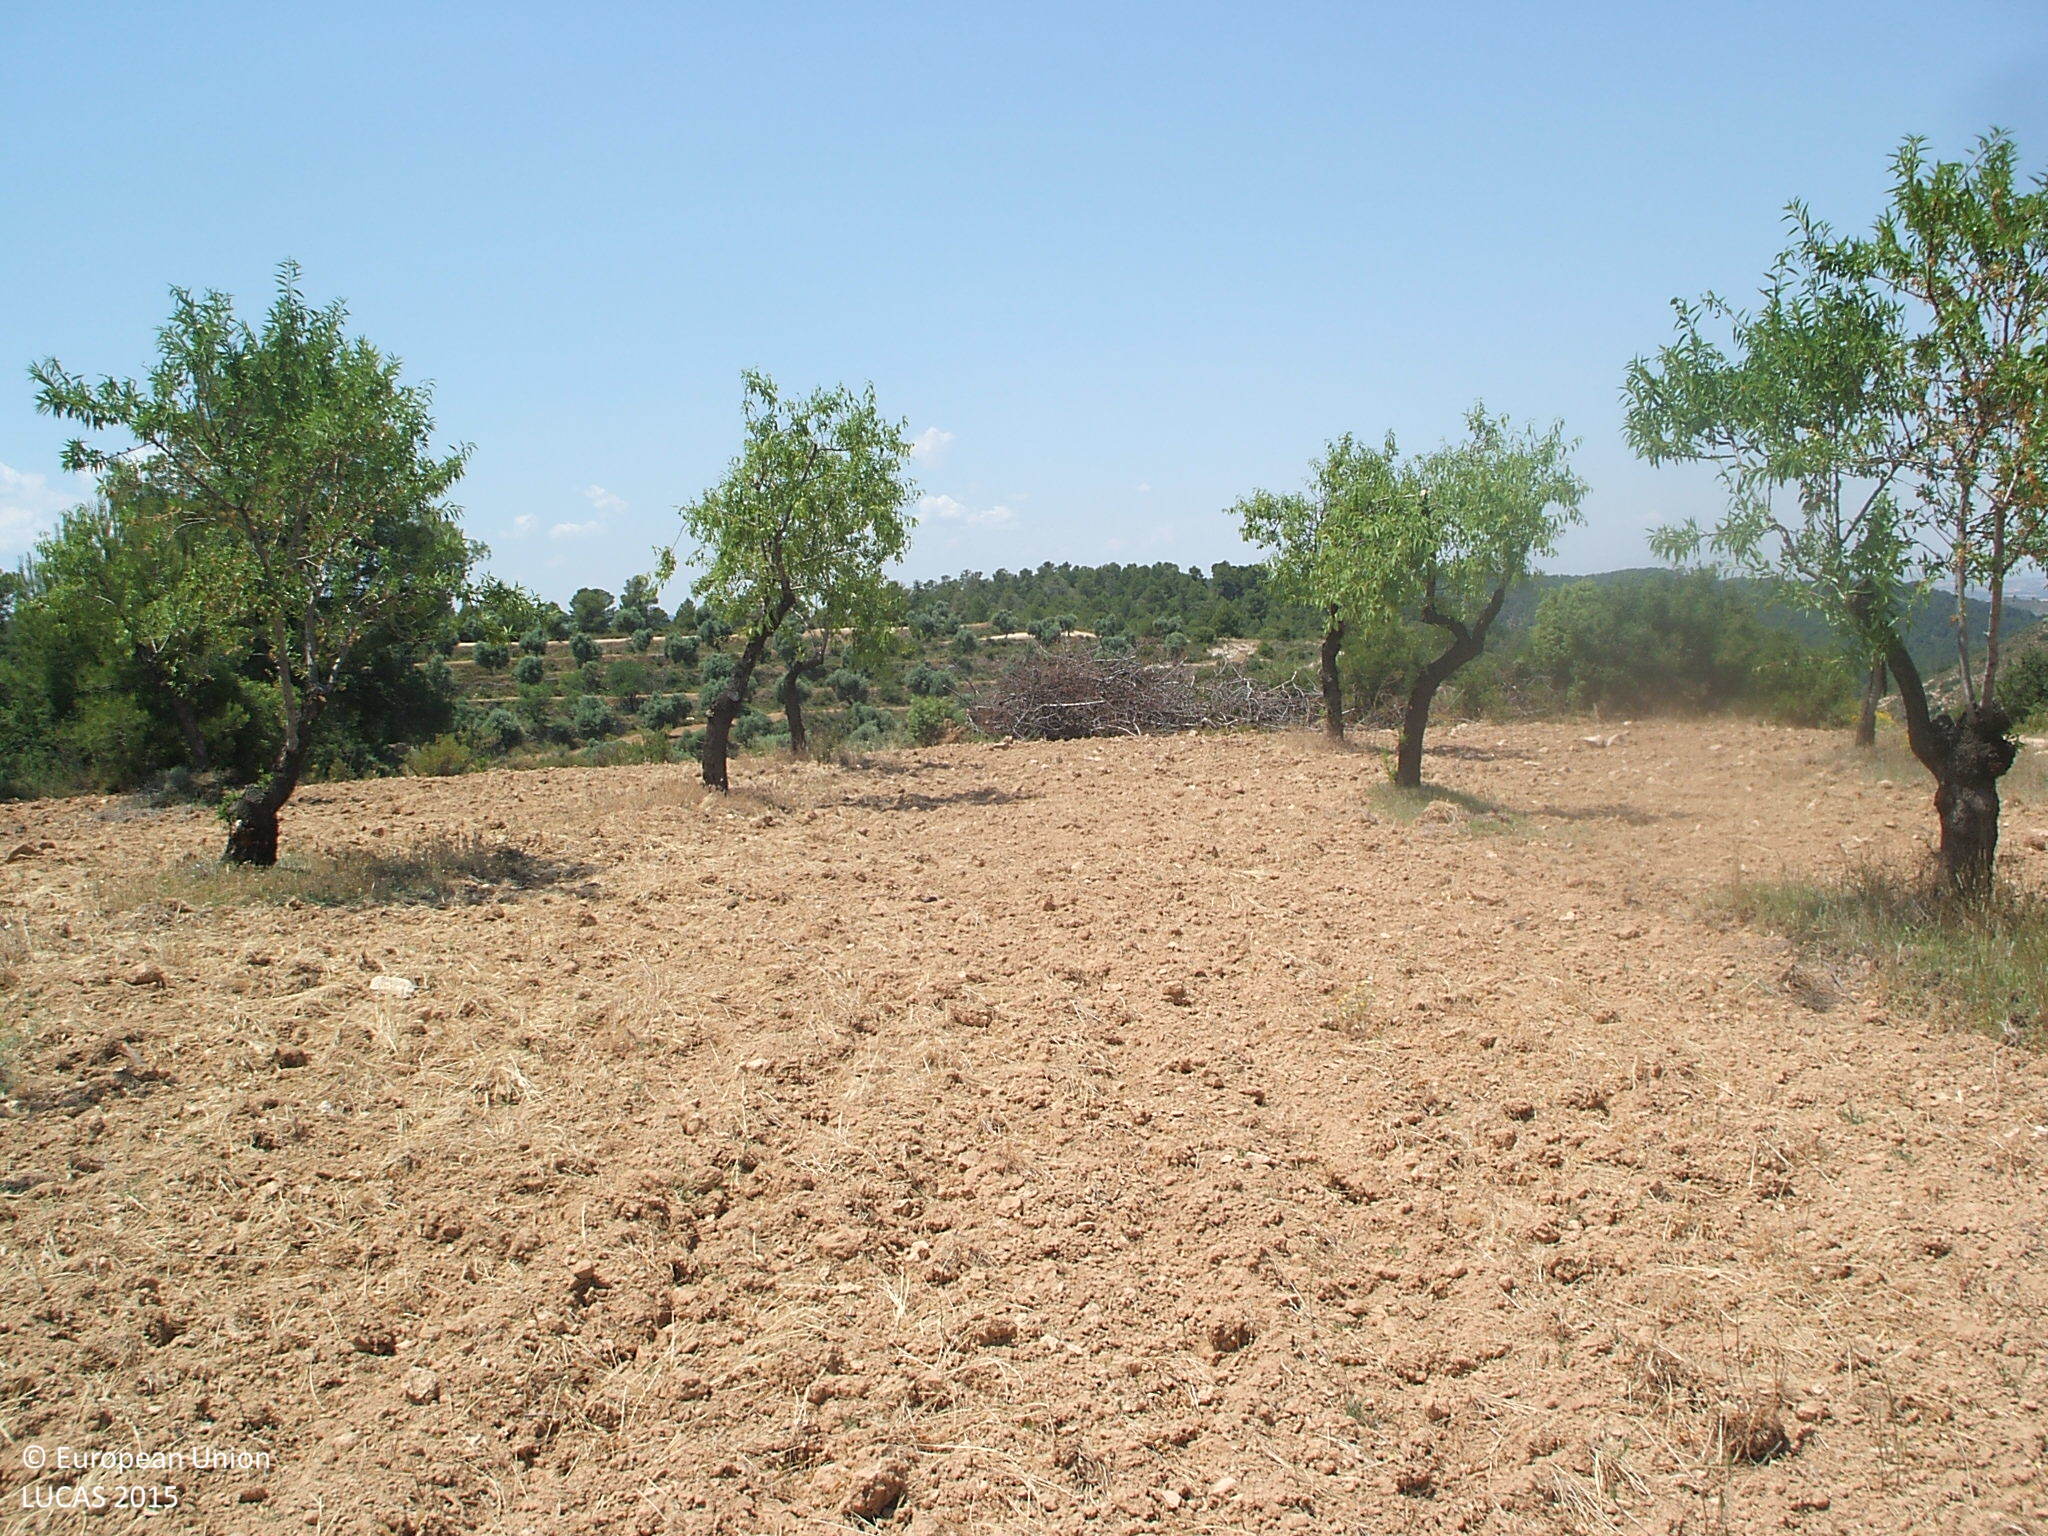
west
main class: Cropland
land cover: Nuts trees
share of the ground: 10 - 25 %
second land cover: Other bare soil
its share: > 75 %
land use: Agriculture (excluding fallow land and kitchen gardens)
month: June
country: ES
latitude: 40.9271
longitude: -0.1162
